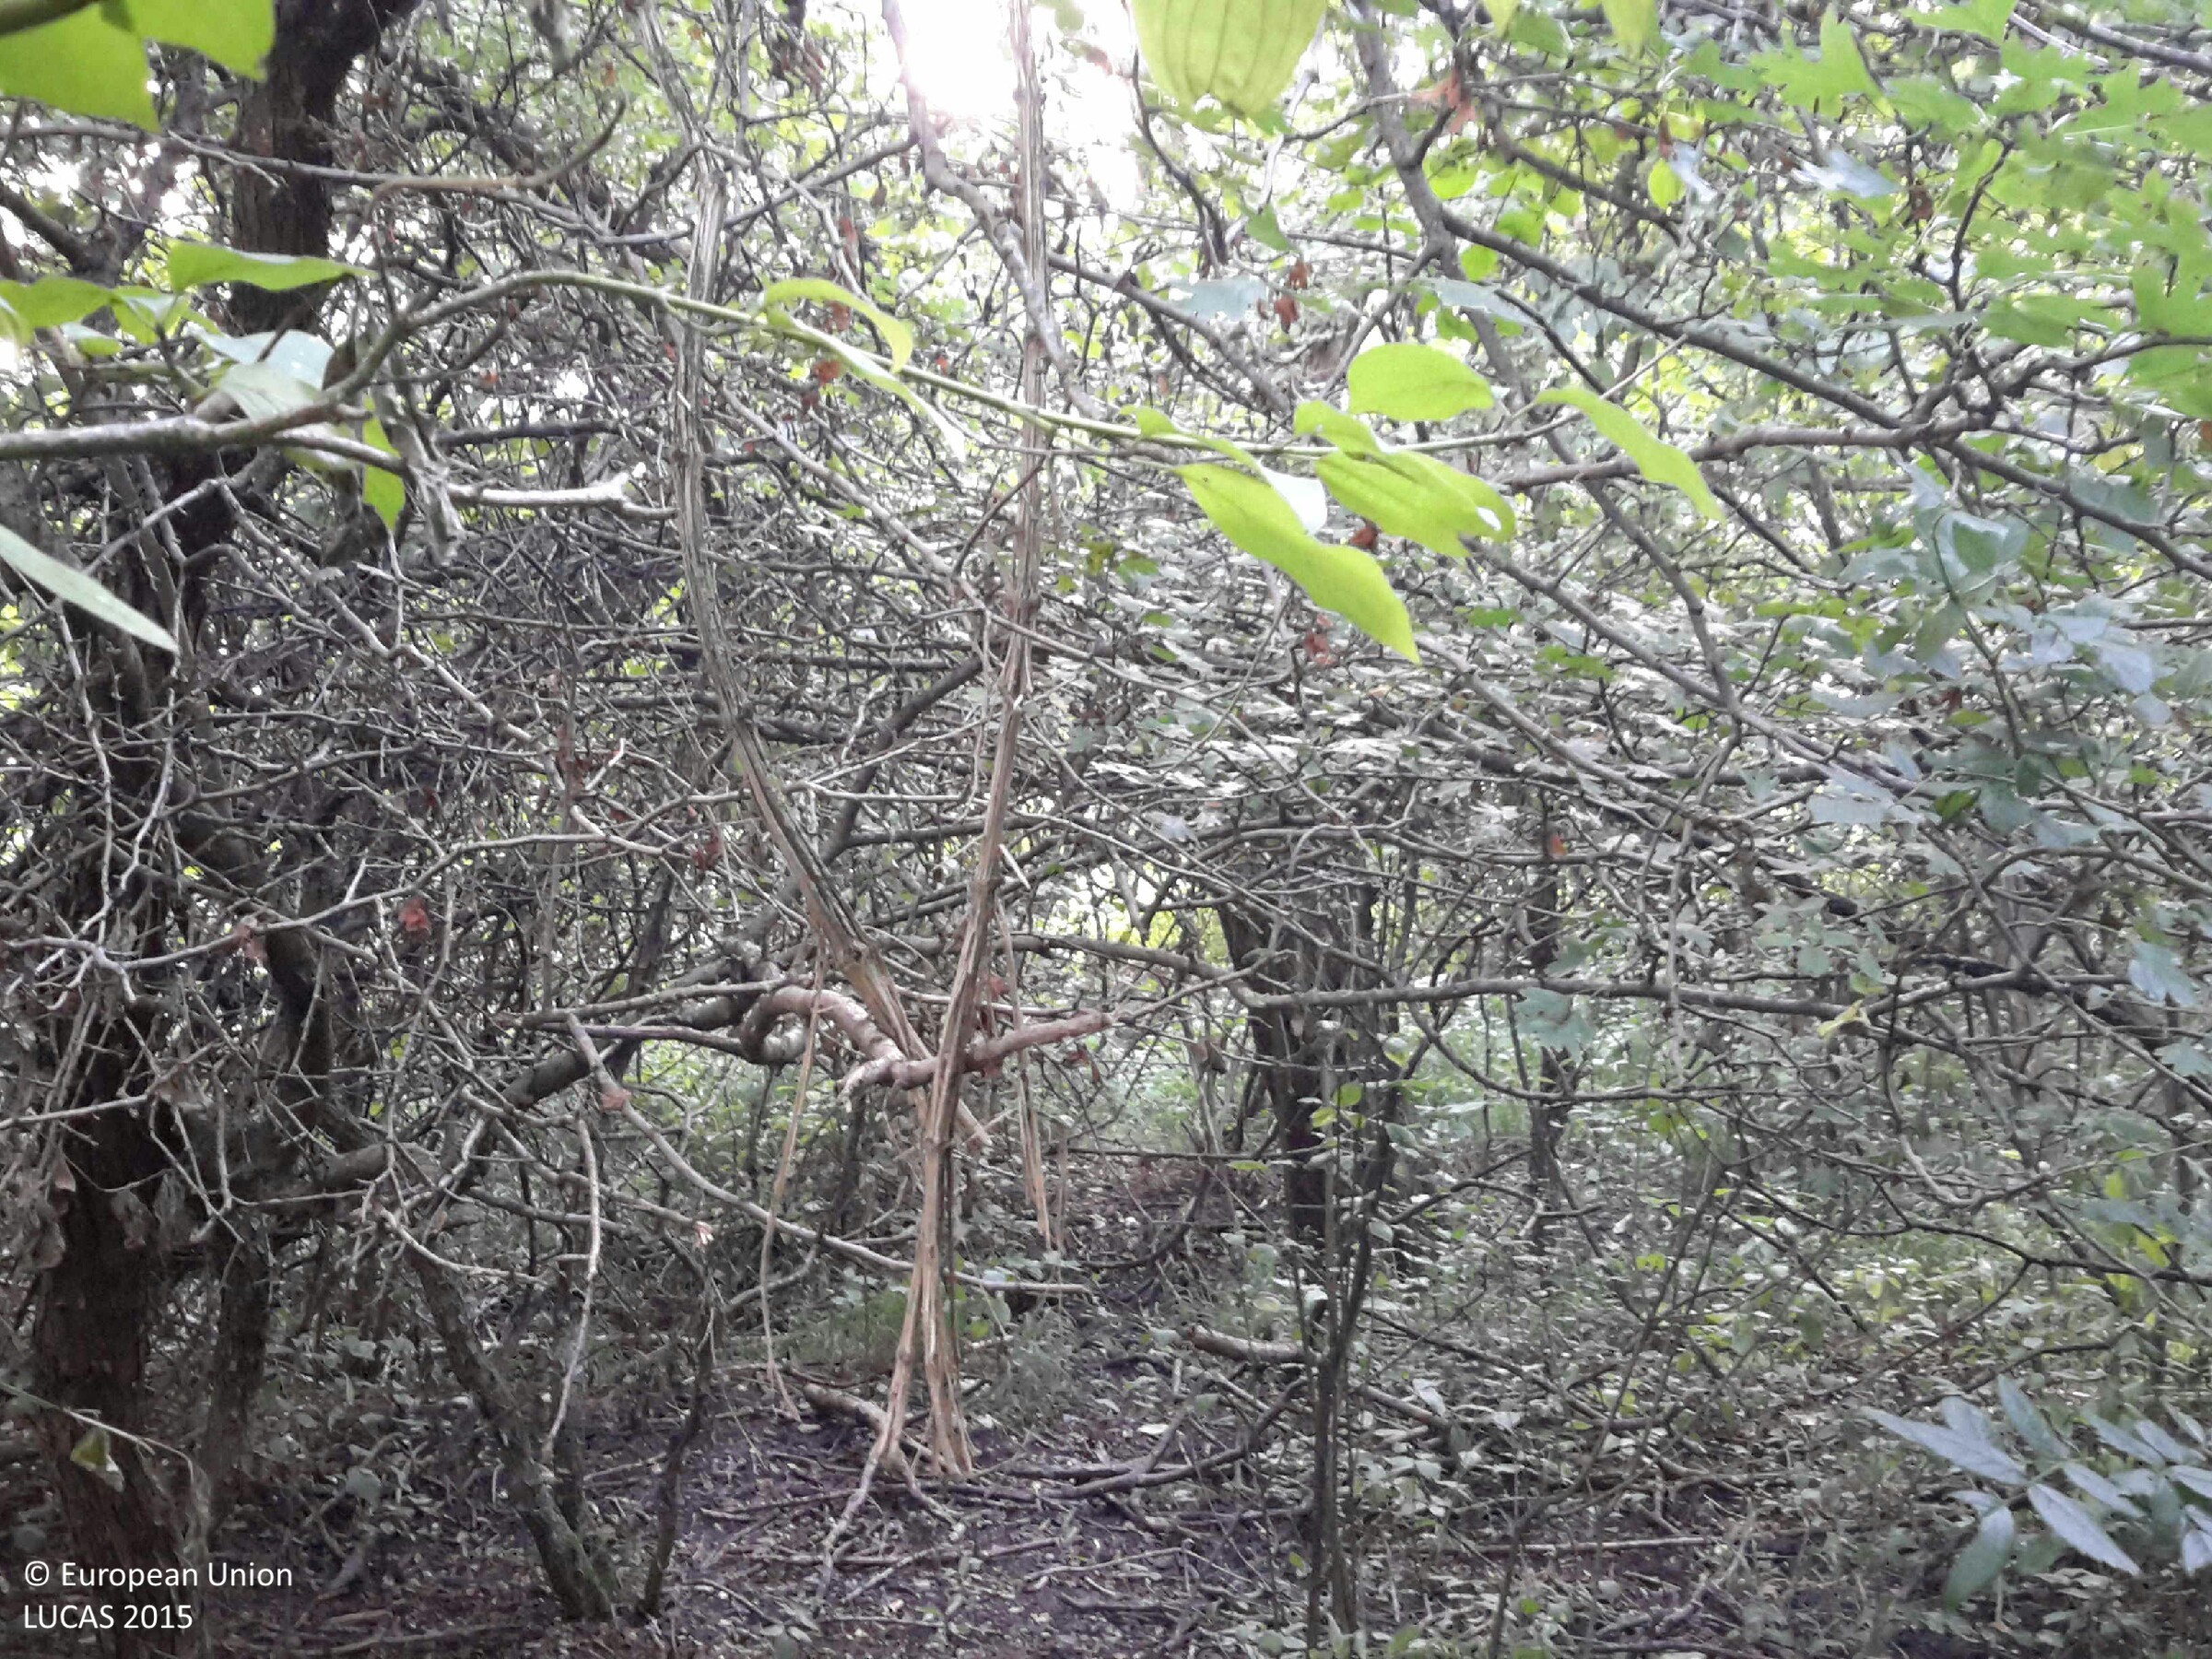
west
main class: Woodland
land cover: Broadleaved woodland
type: thermophilous deciduous forest
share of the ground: > 75 %
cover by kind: broadleaved forest trees 60 %, shrubs 30 %, herbaceous plants 10 %
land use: Forestry
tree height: > 5 m
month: August
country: HU
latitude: 47.2702
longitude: 17.3956
